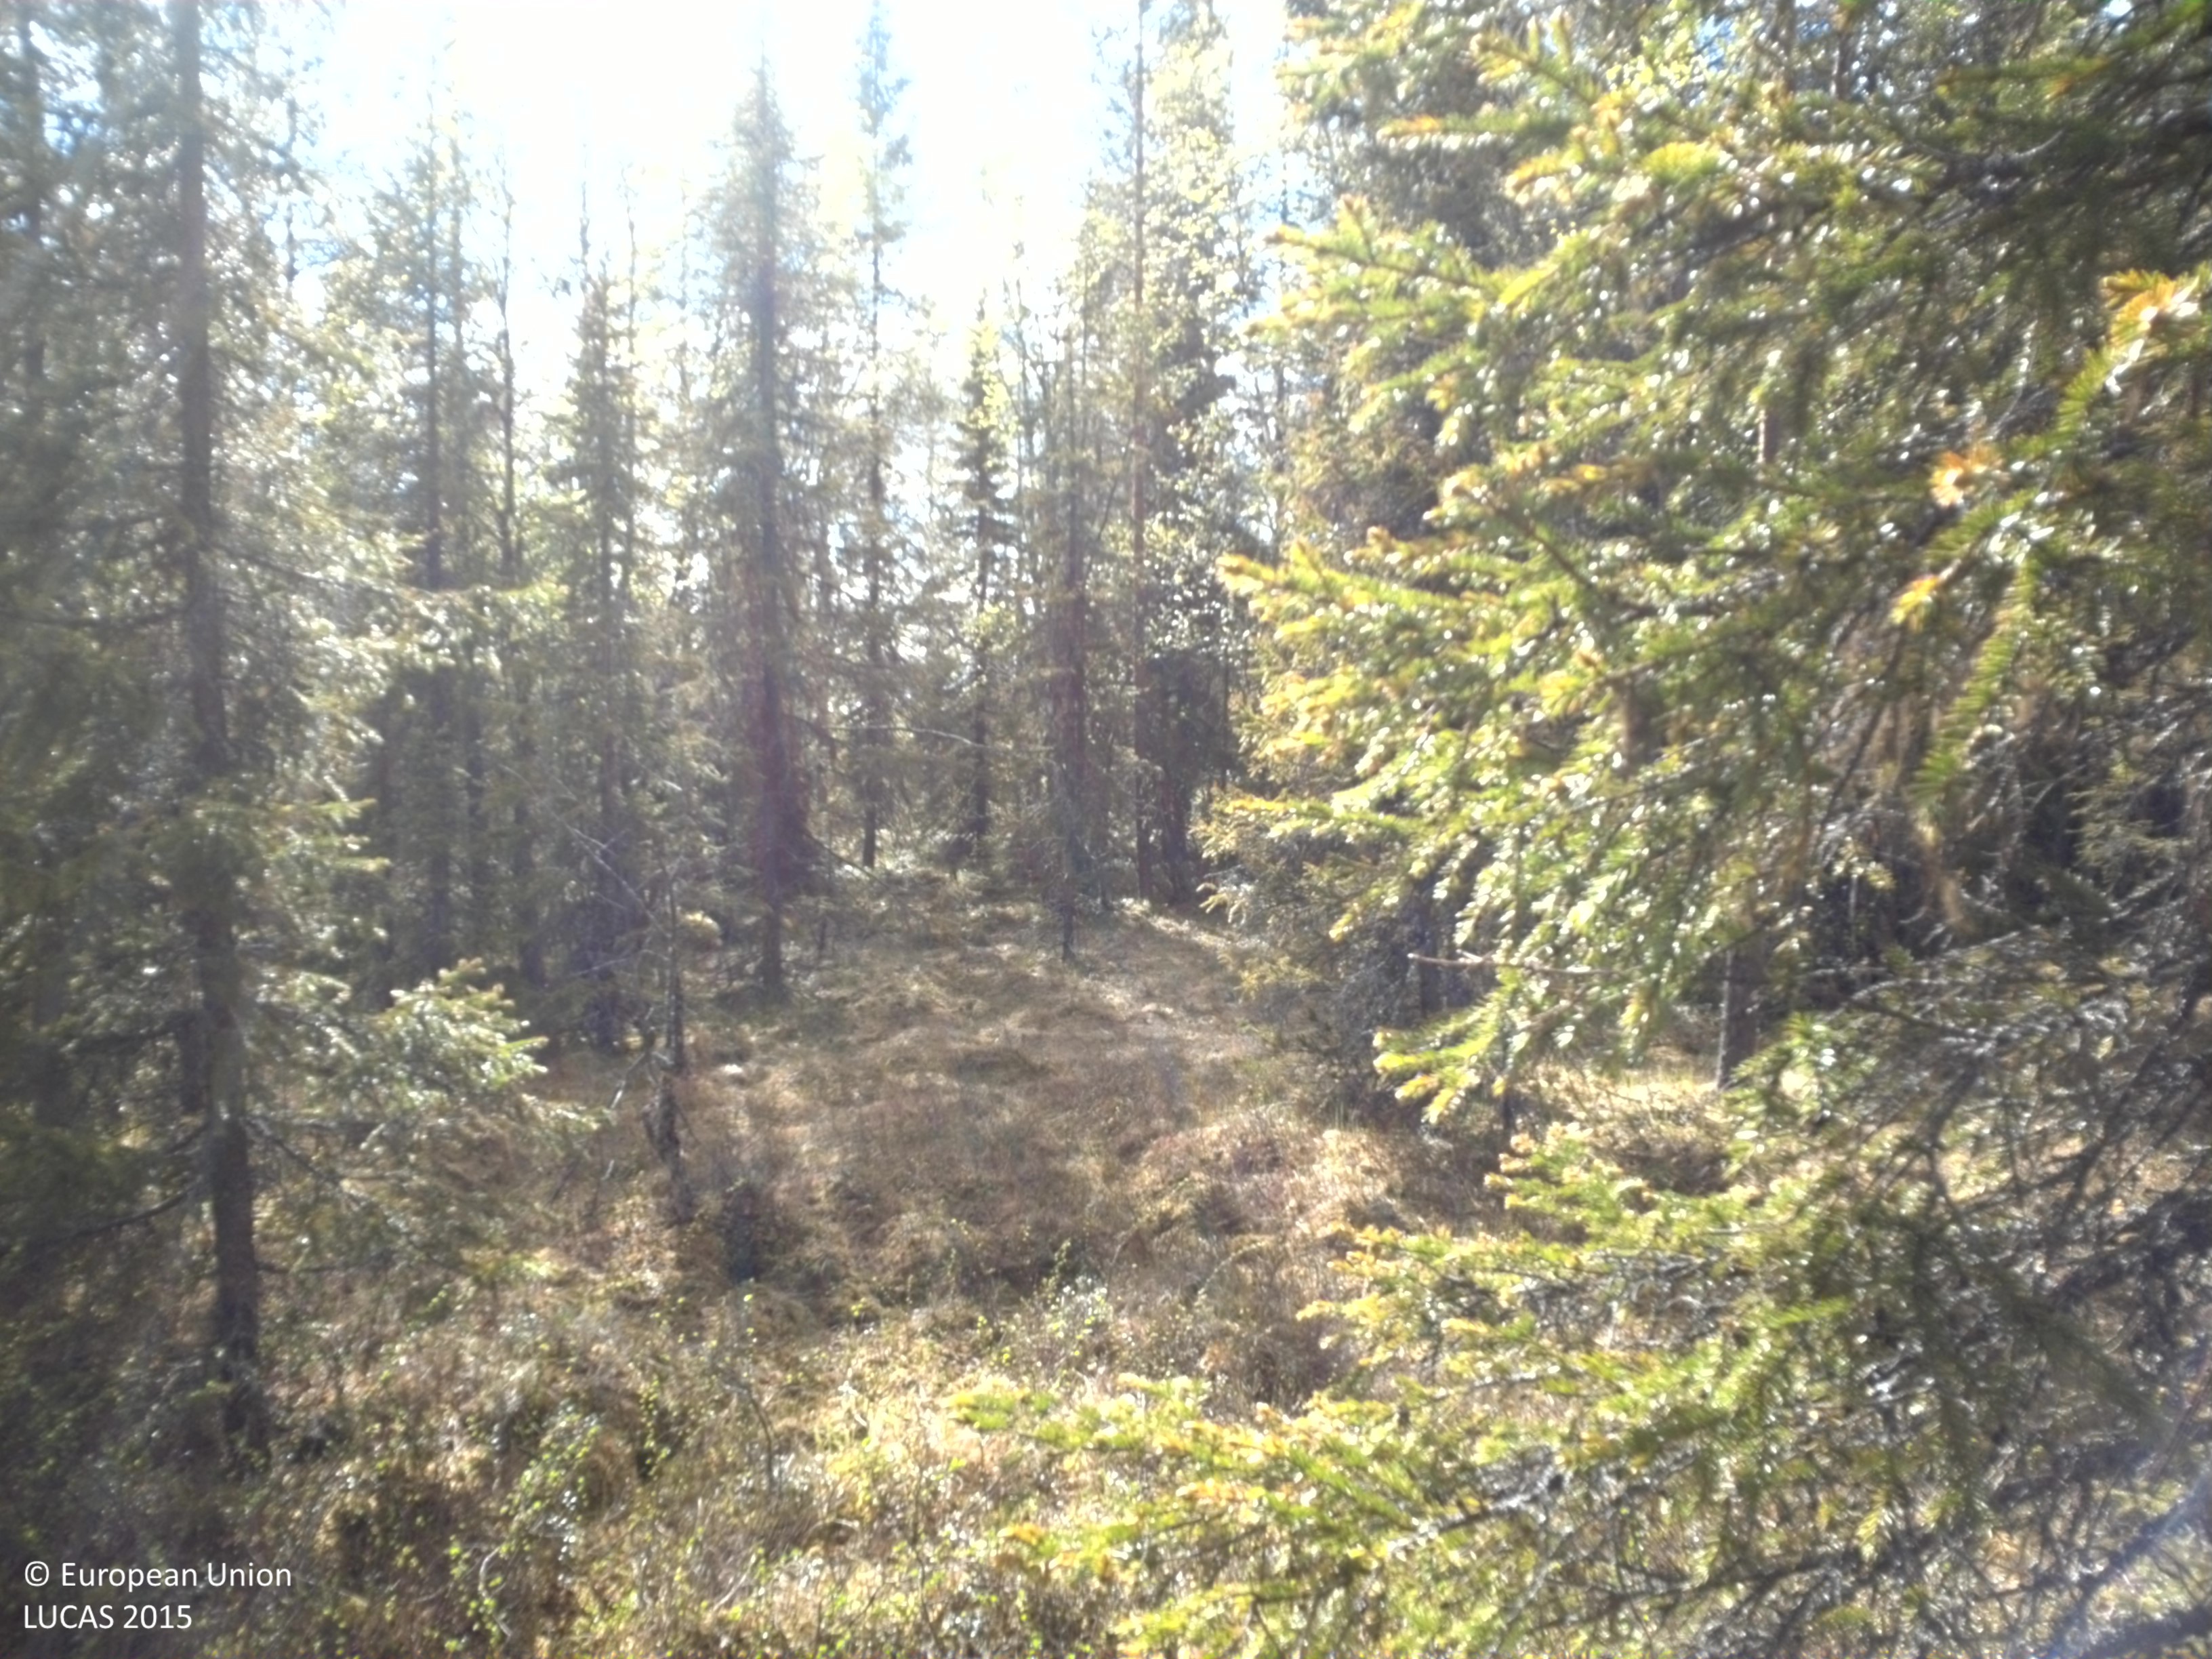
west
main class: Woodland
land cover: Pine dominated mixed woodland
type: boreal forest
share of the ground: 25 - 50 %
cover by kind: coniferous forest trees 35 %, shrubs 25 %, broadleaved forest trees 15 %, lichens and mosses 15 %, herbaceous plants 10 %
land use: Forestry
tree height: > 5 m
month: June
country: SE
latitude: 64.2890
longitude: 17.5920
